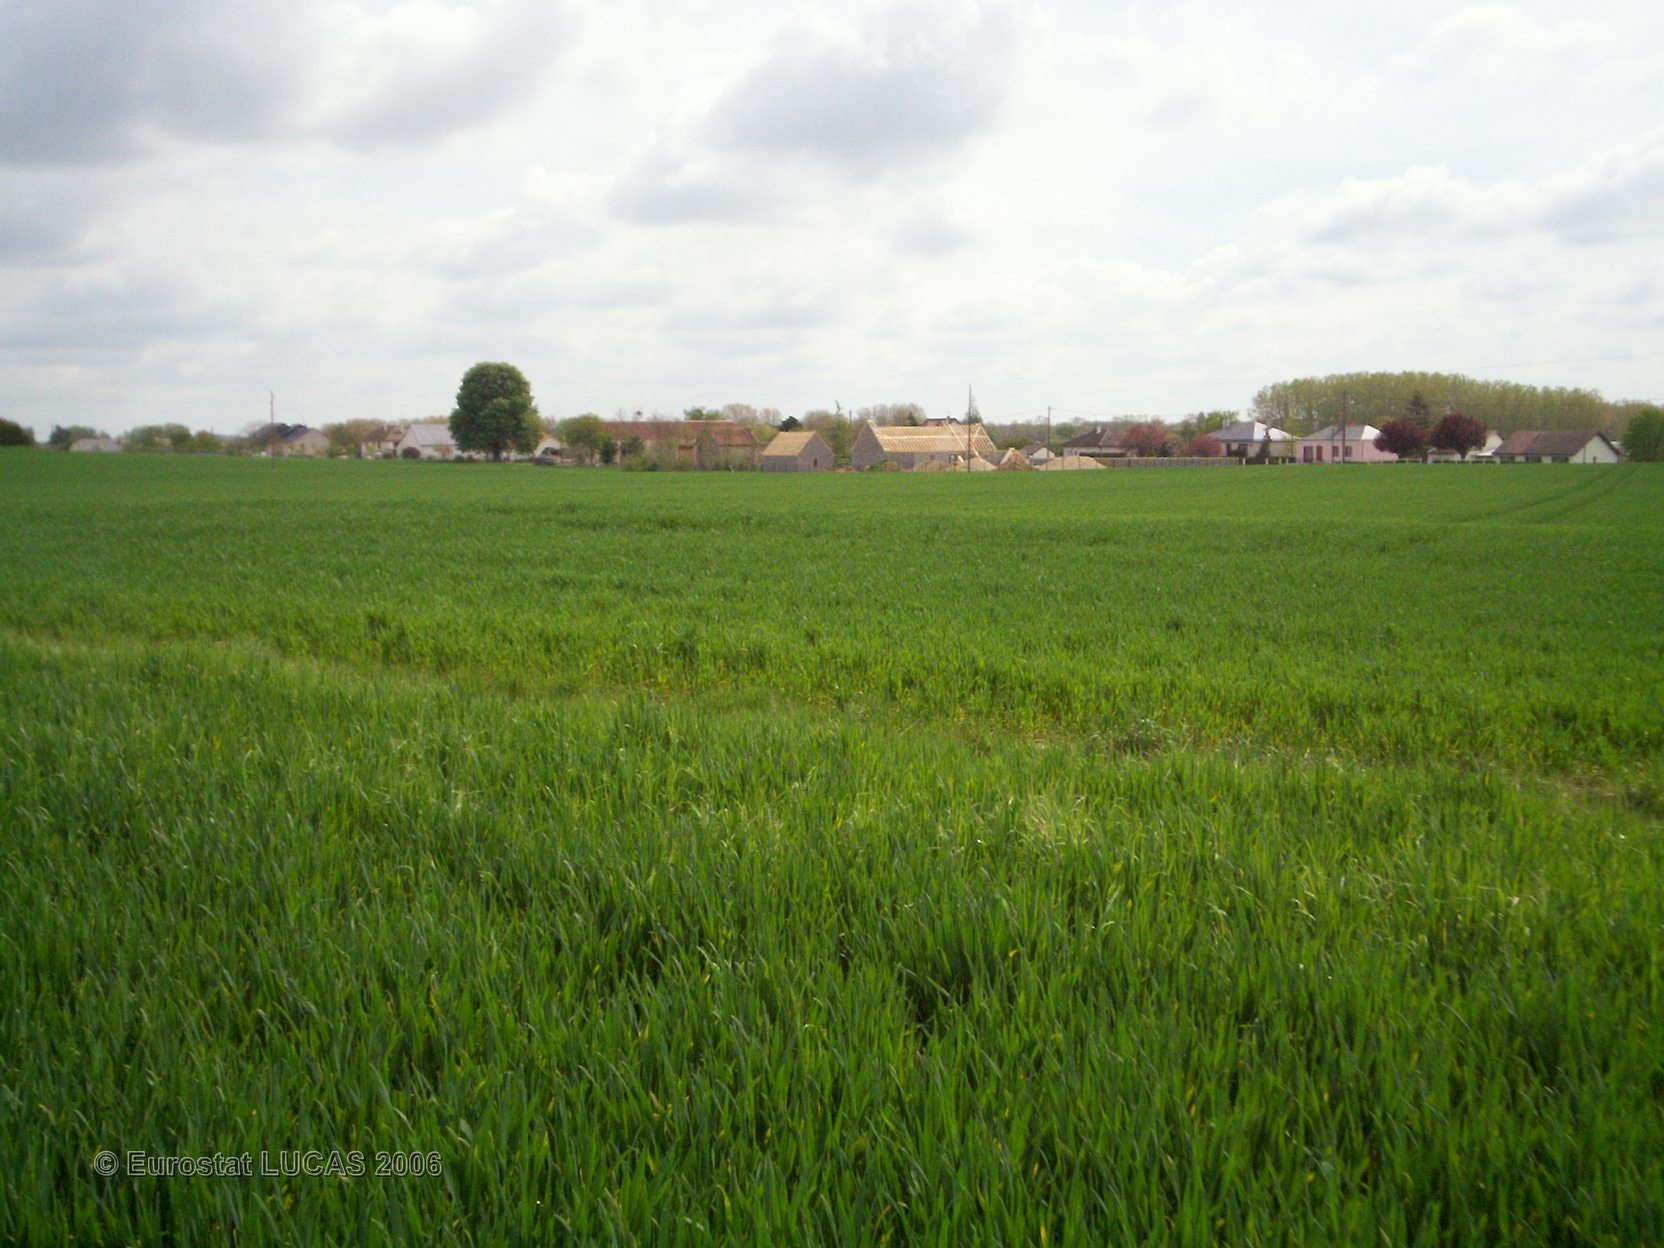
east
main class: Cropland
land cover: Common wheat
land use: Agriculture (excluding fallow land and kitchen gardens)
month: April
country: FR
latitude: 47.0163
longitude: 0.3098
